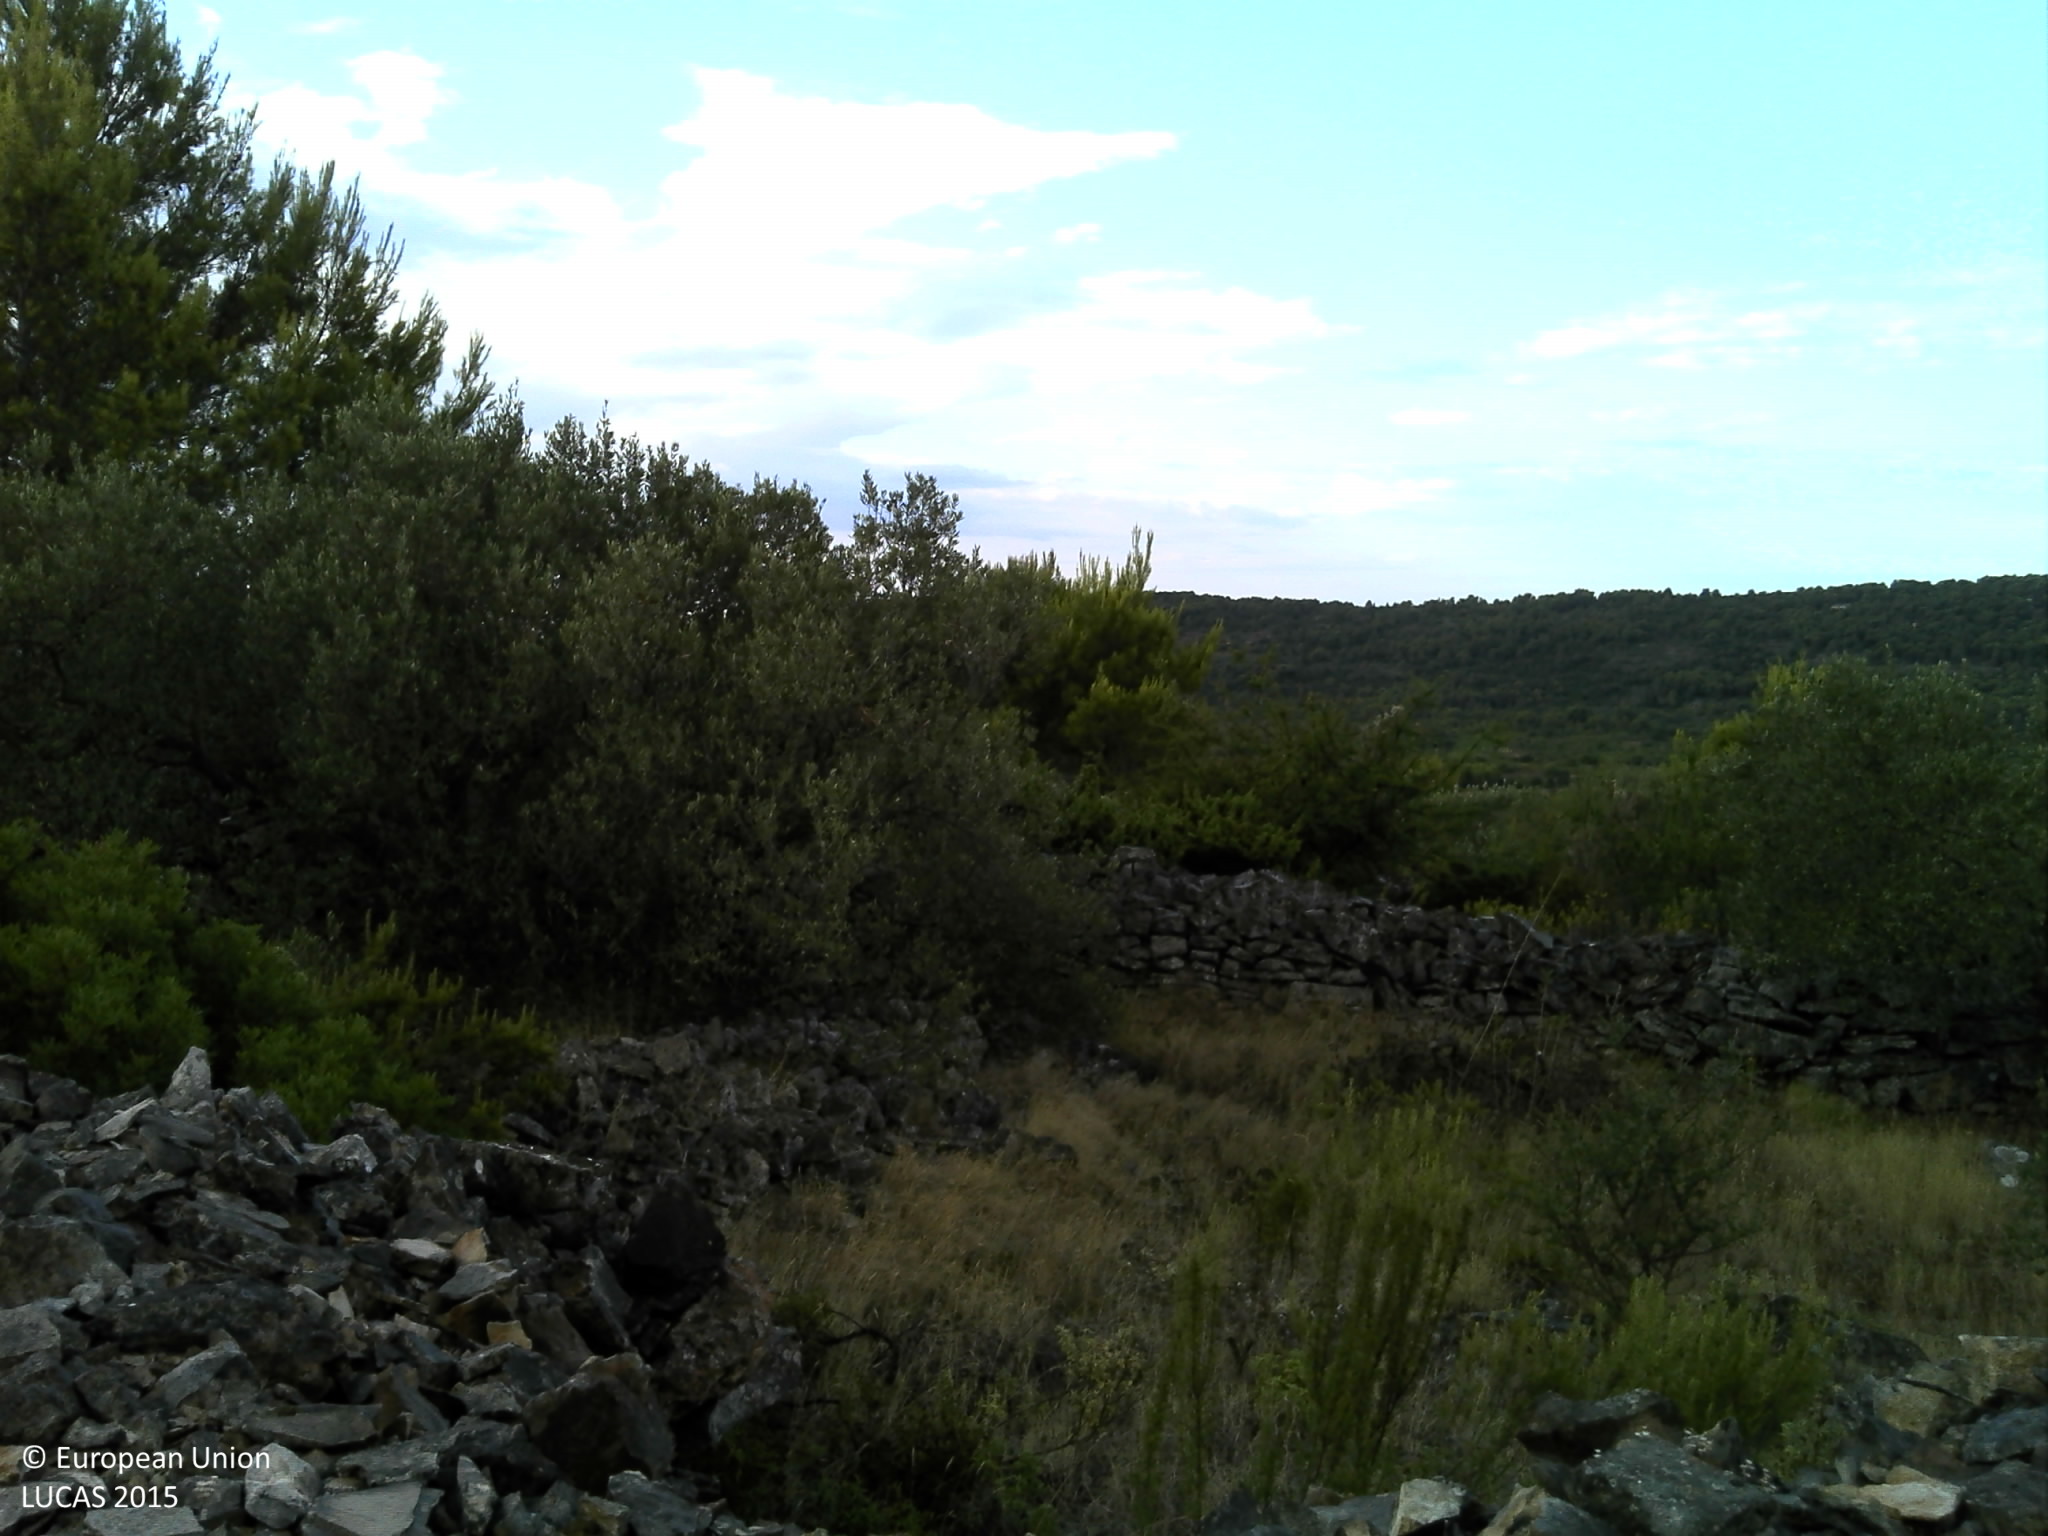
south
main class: Cropland
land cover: Olive groves
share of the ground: 50 - 75 %
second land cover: Other bare soil
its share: > 75 %
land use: Agriculture (excluding fallow land and kitchen gardens)
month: August
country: HR
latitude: 43.4008
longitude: 16.2749
